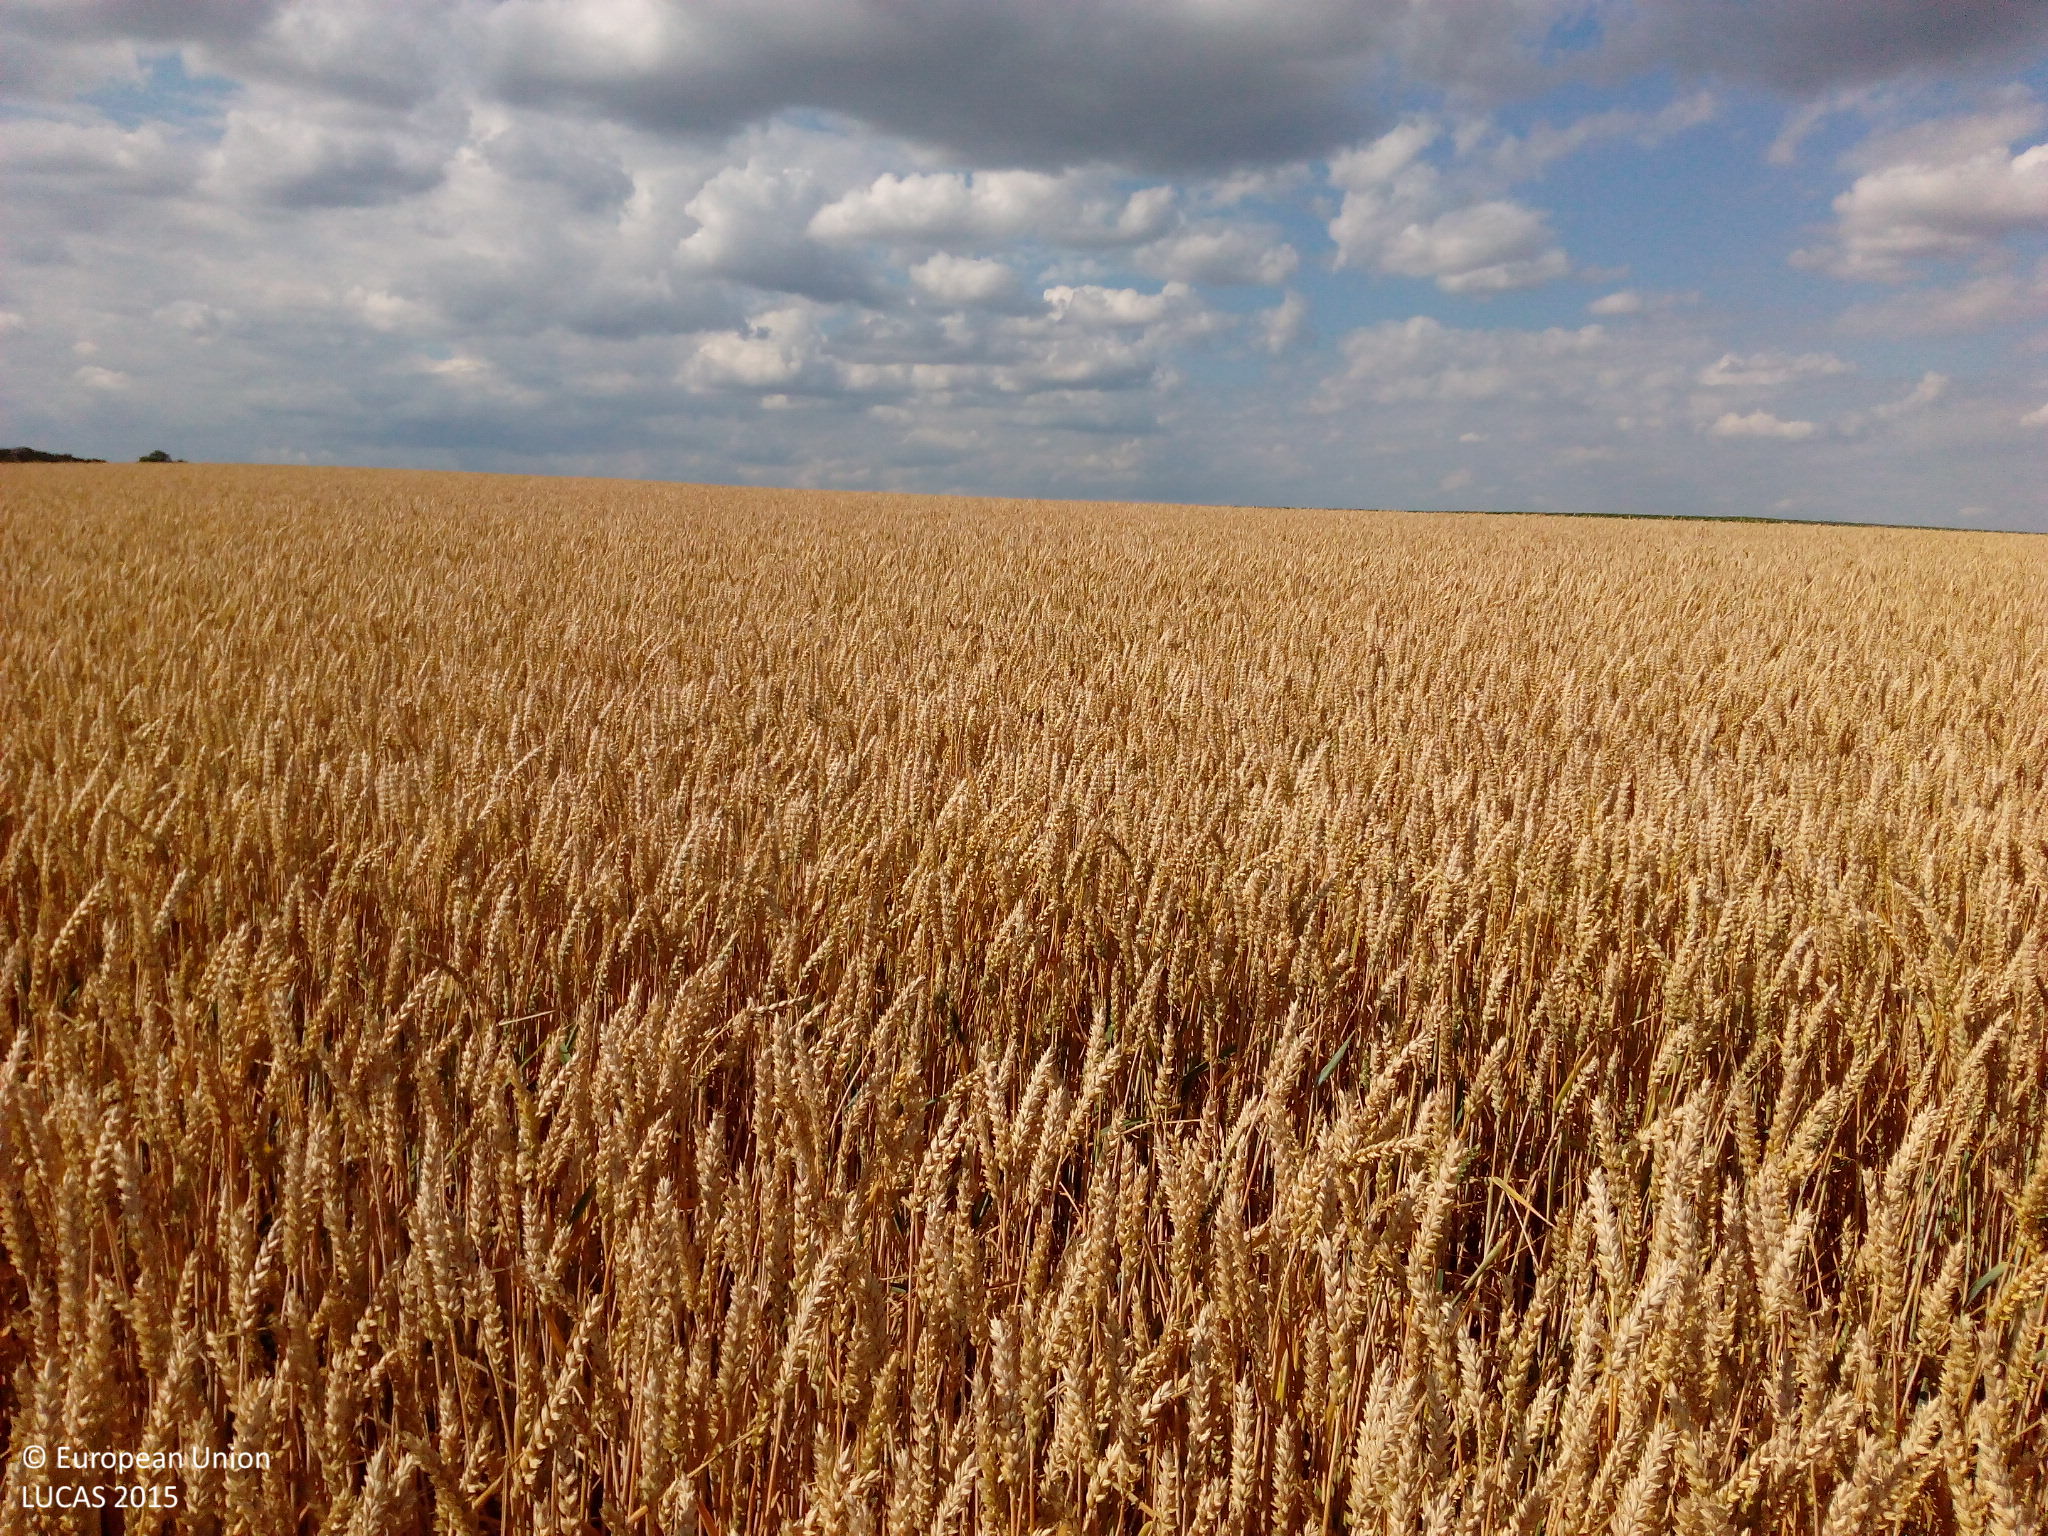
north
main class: Cropland
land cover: Common wheat
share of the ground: > 75 %
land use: Agriculture (excluding fallow land and kitchen gardens)
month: July
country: DE
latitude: 49.6807
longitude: 9.9584
